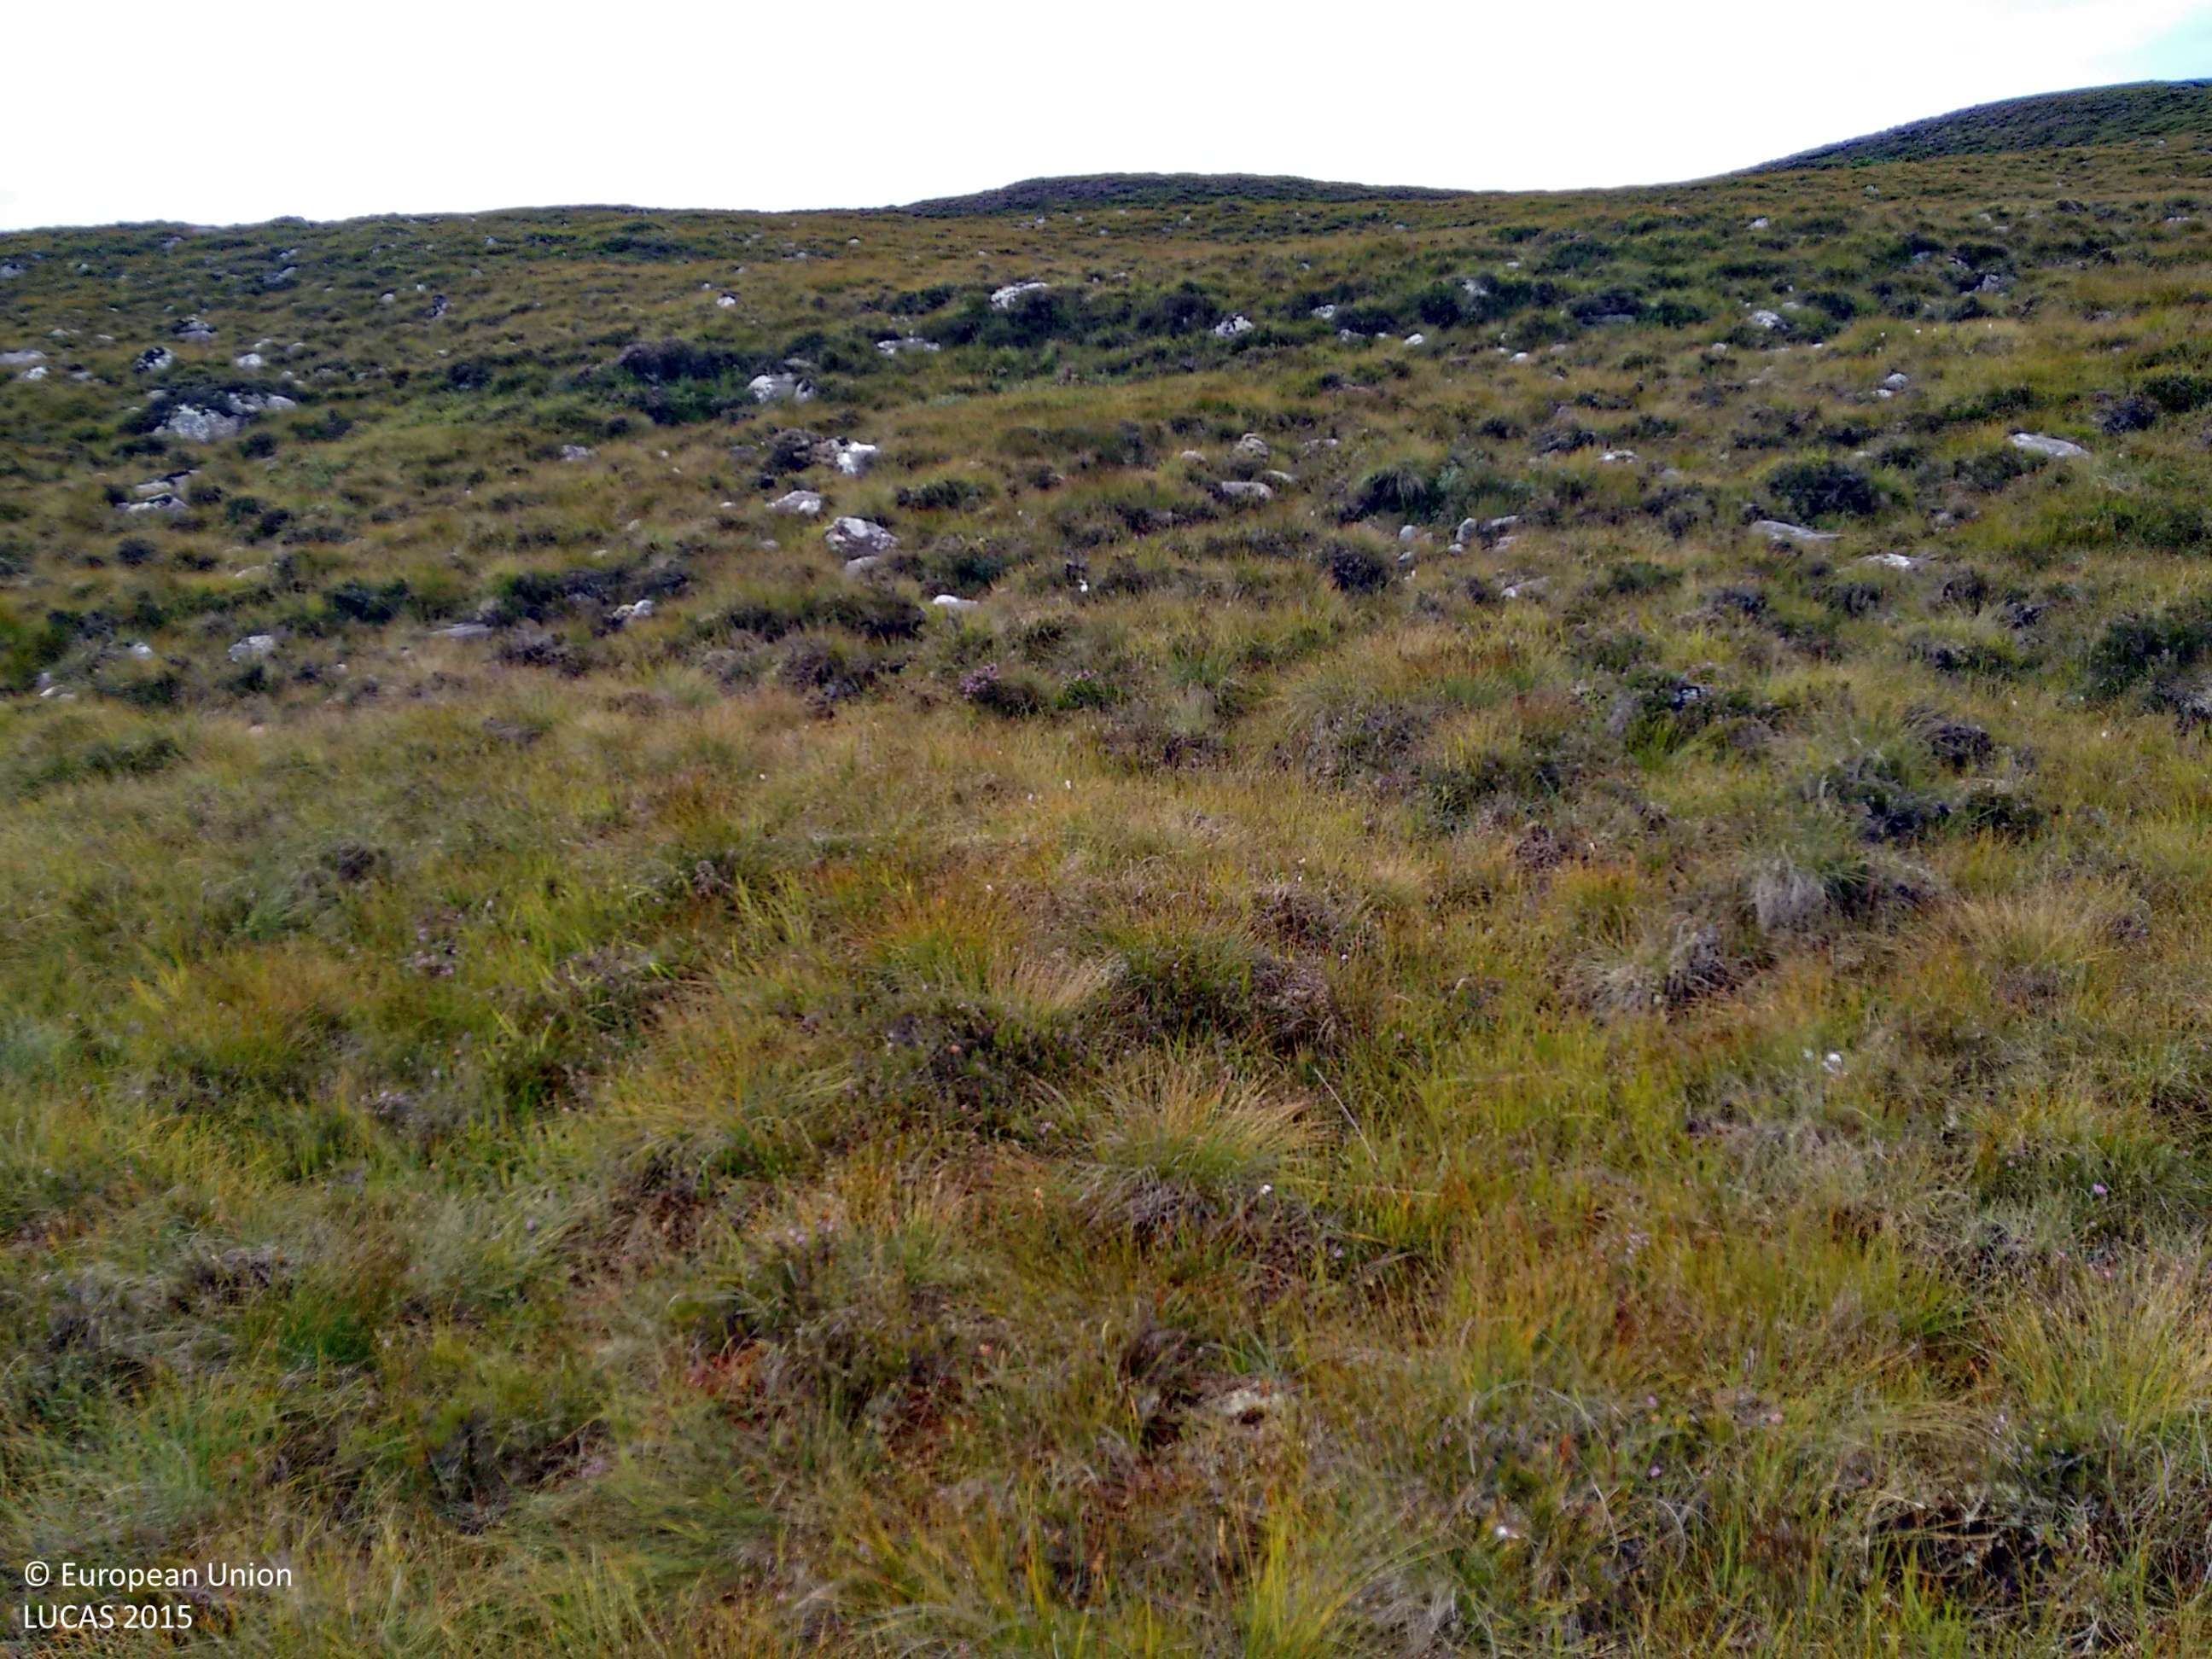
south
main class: Shrubland
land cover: Shrubland without tree cover
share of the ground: > 75 %
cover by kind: herbaceous plants 60 %, shrubs 40 %
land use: Agriculture (excluding fallow land and kitchen gardens)
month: September
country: GB
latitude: 57.6841
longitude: -5.7691
